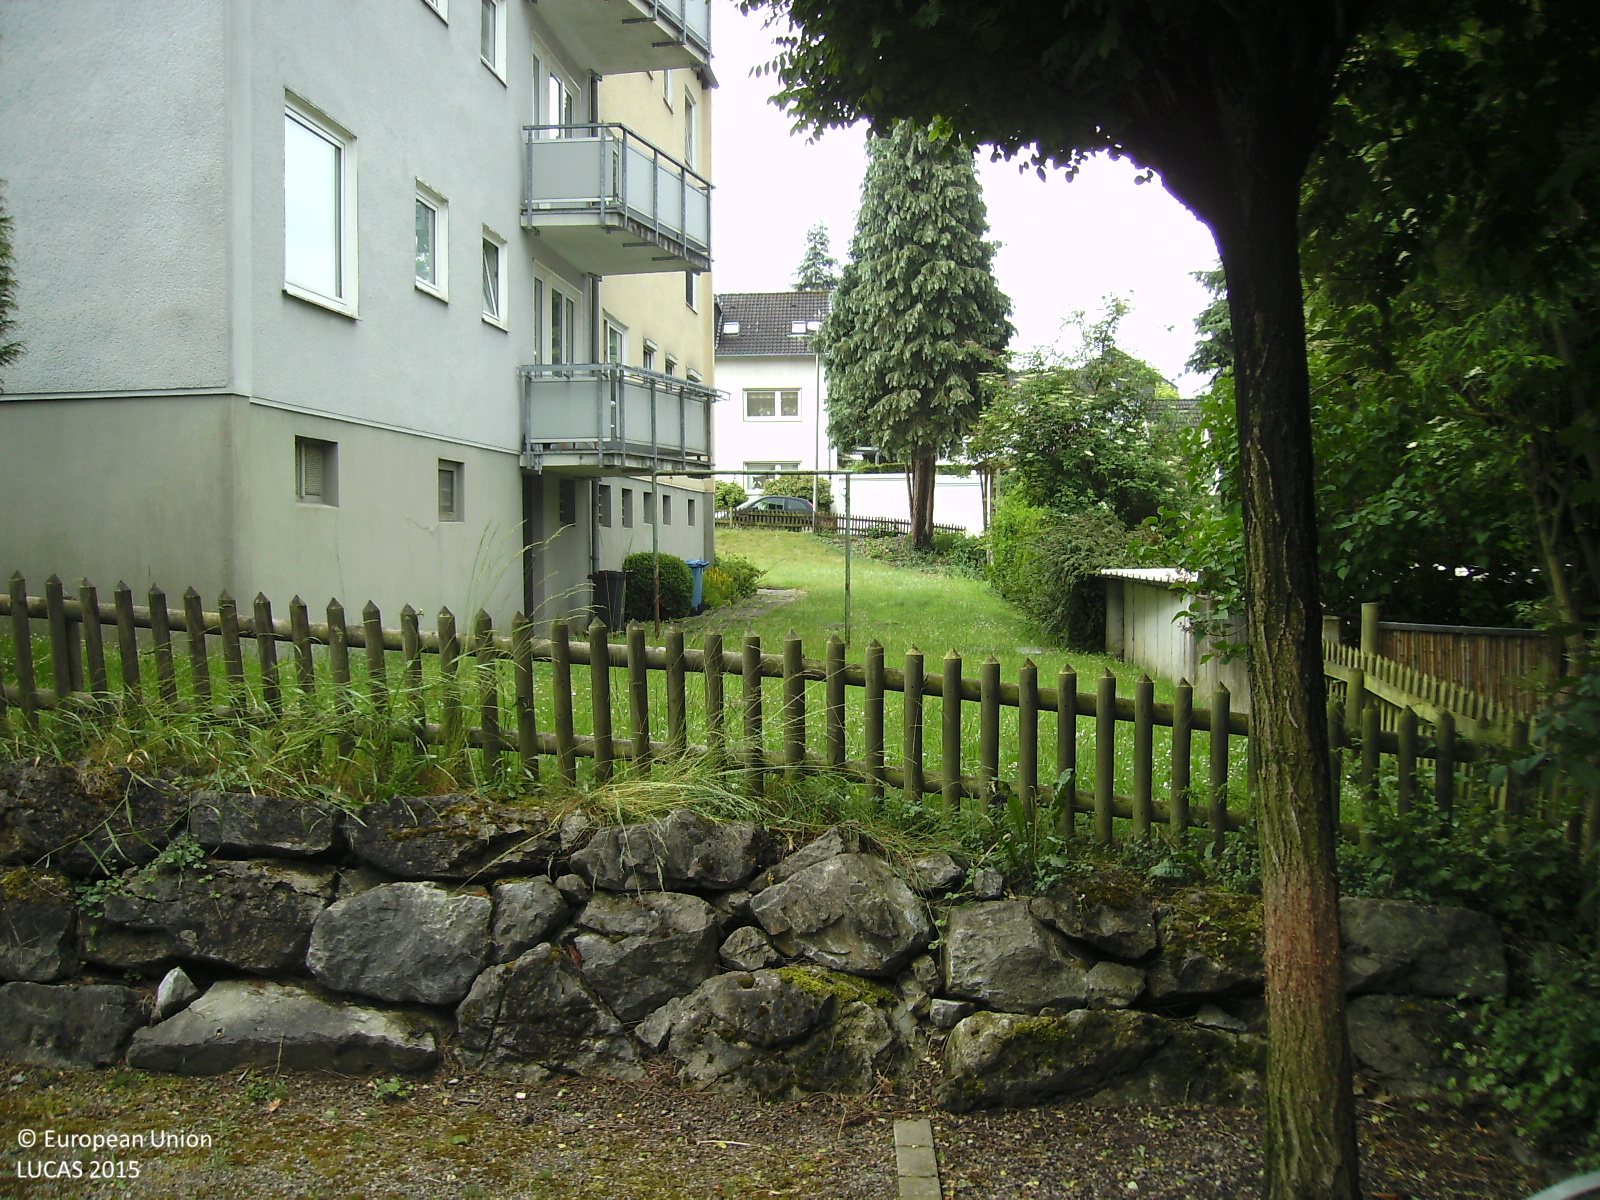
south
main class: Grassland
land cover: Grassland without tree/shrub cover
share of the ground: > 75 %
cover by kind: herbaceous plants 100 %
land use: Residential
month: June
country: DE
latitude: 51.2791
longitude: 7.0324
